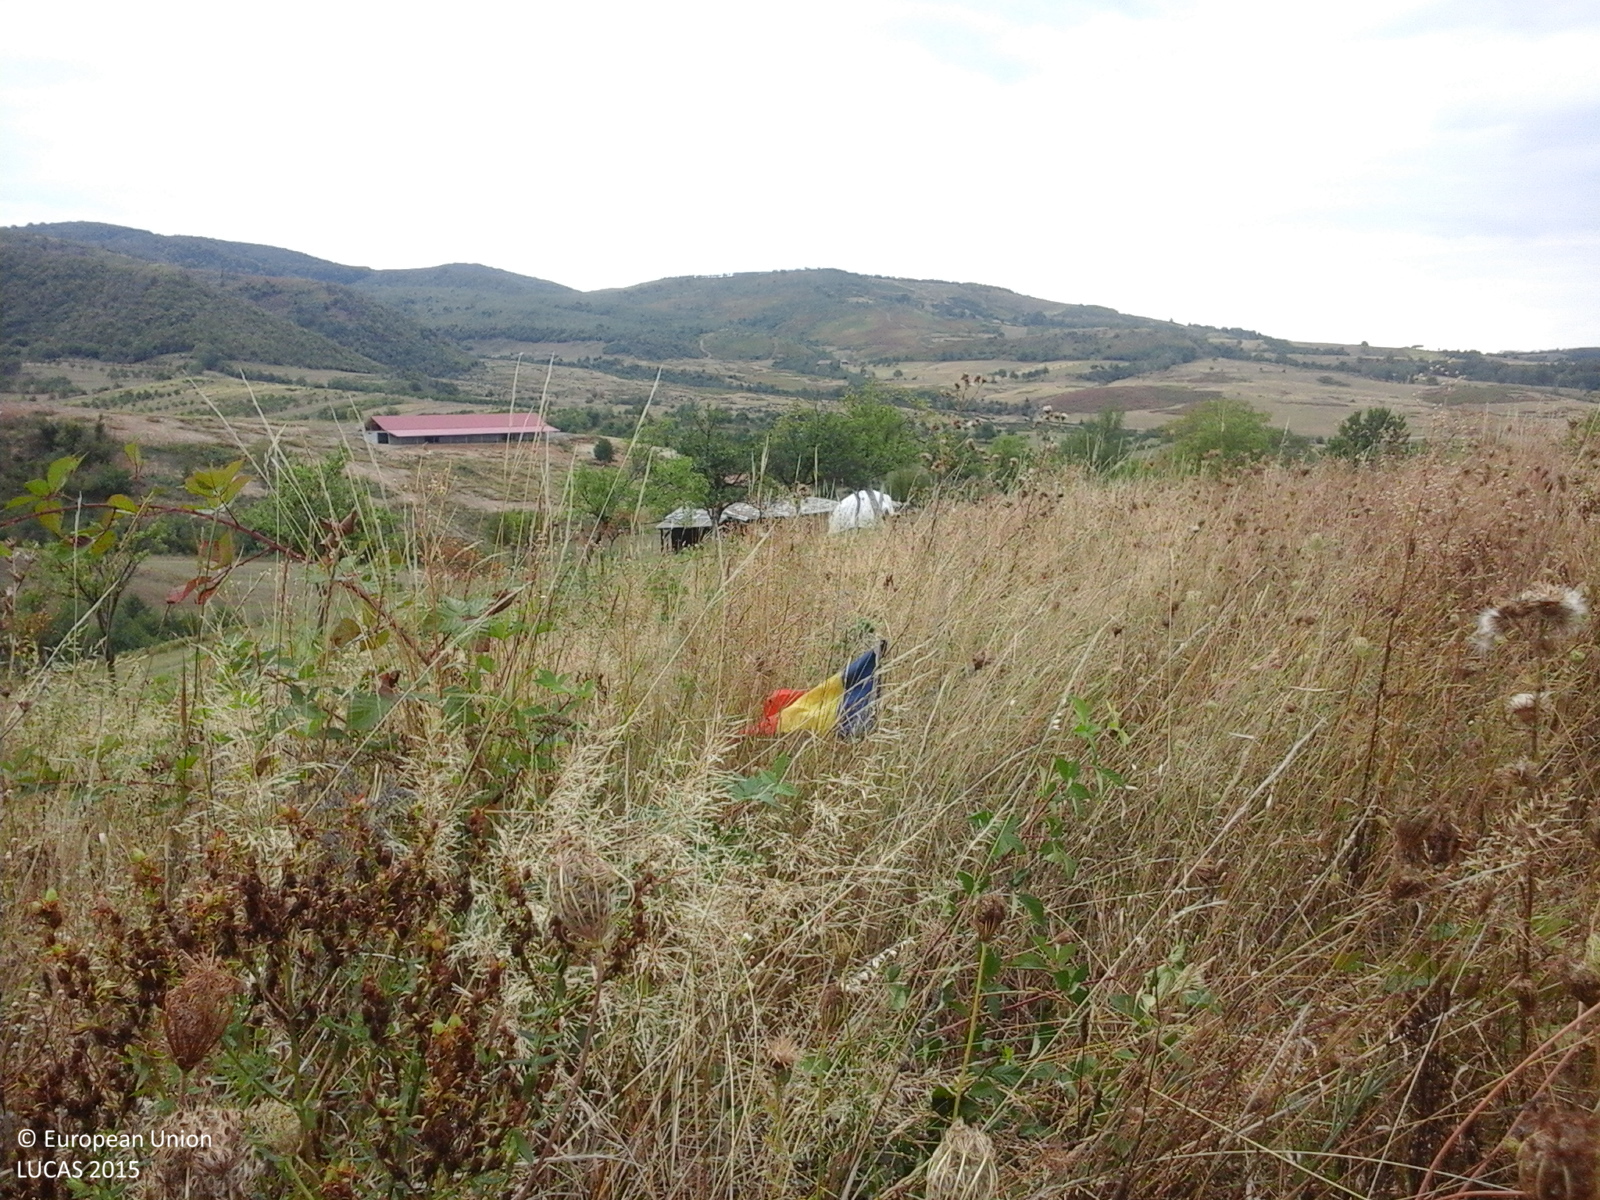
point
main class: Grassland
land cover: Spontaneously vegetated surfaces
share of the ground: > 75 %
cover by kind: herbaceous plants 100 %
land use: Fallow land
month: September
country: RO
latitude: 47.8216
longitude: 23.3903
